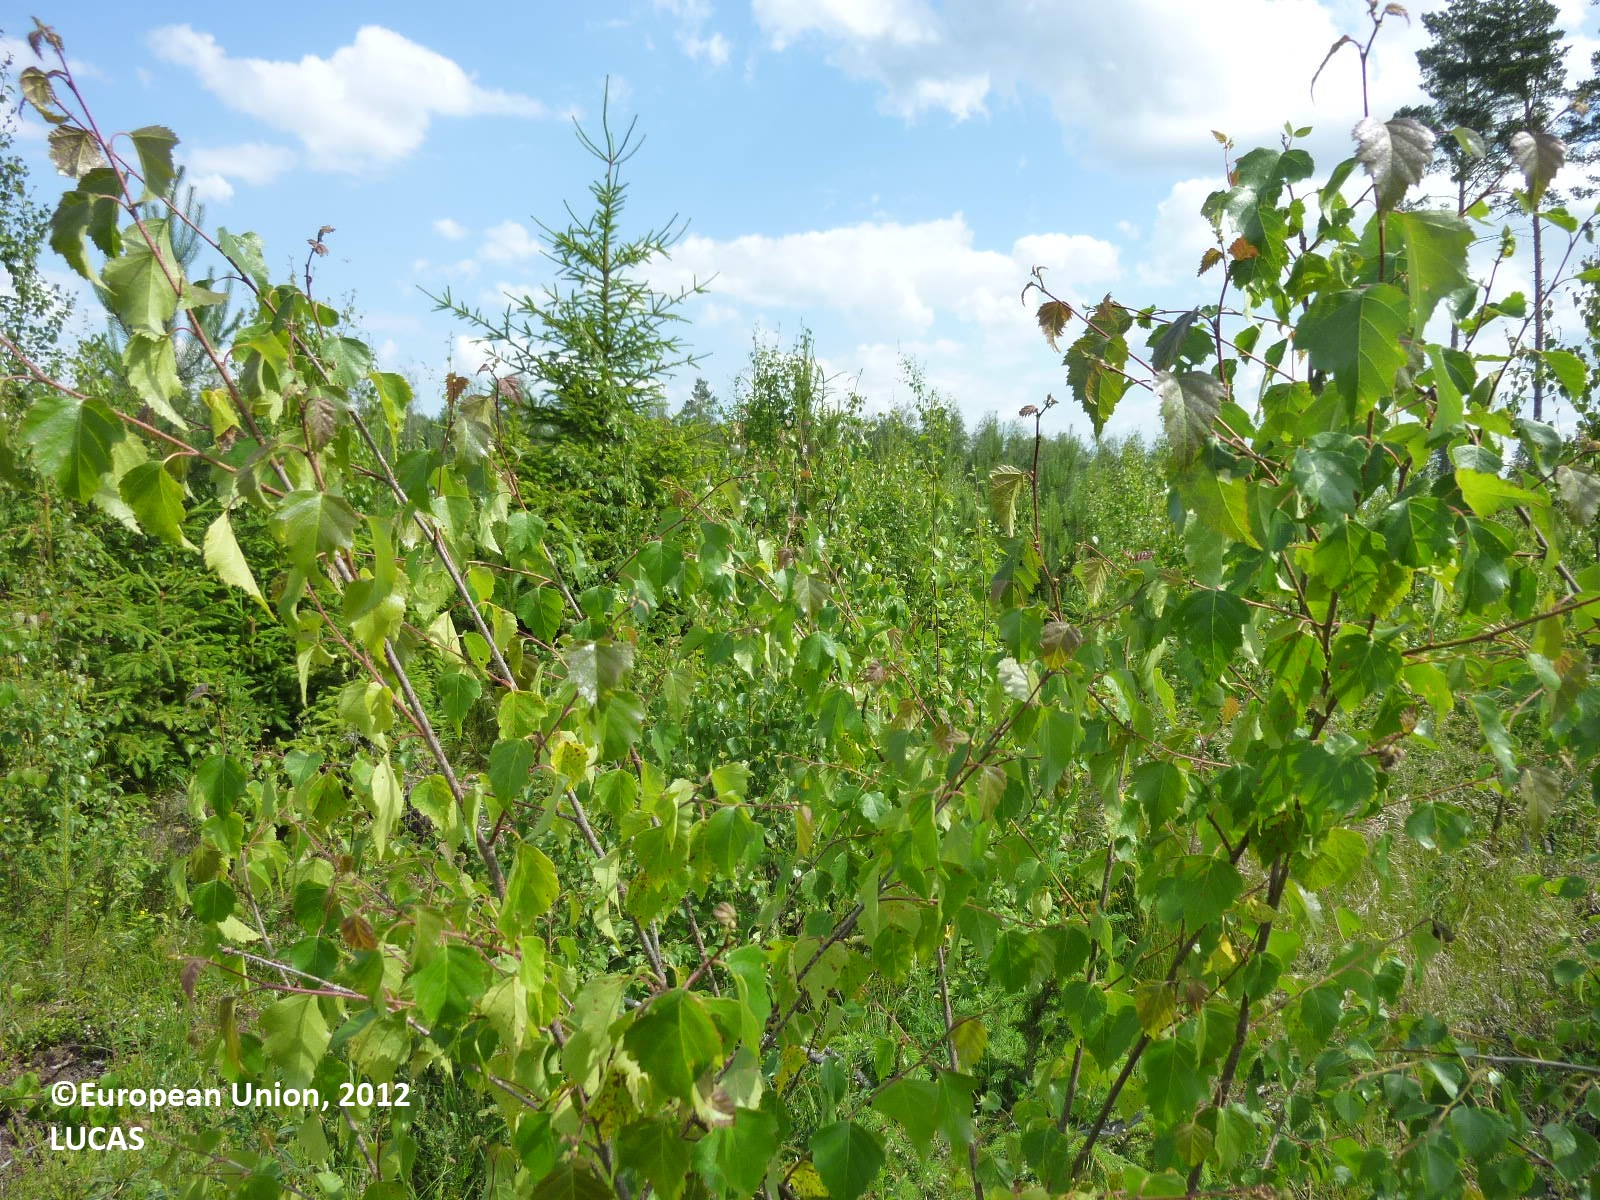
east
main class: Woodland
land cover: Other mixed woodland
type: boreal forest
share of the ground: 50 - 75 %
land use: Forestry
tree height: < 5 m
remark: Clear cut
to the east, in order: Other mixed woodland; Ditches and canals; Other mixed woodland; Ditches and canals; Other mixed woodland; Ditches and canals; Other mixed woodland; Ditches and canals; Broadleaved woodland; Ditches and canals; Broadleaved woodland
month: July
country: FI
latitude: 61.2046
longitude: 22.3652
